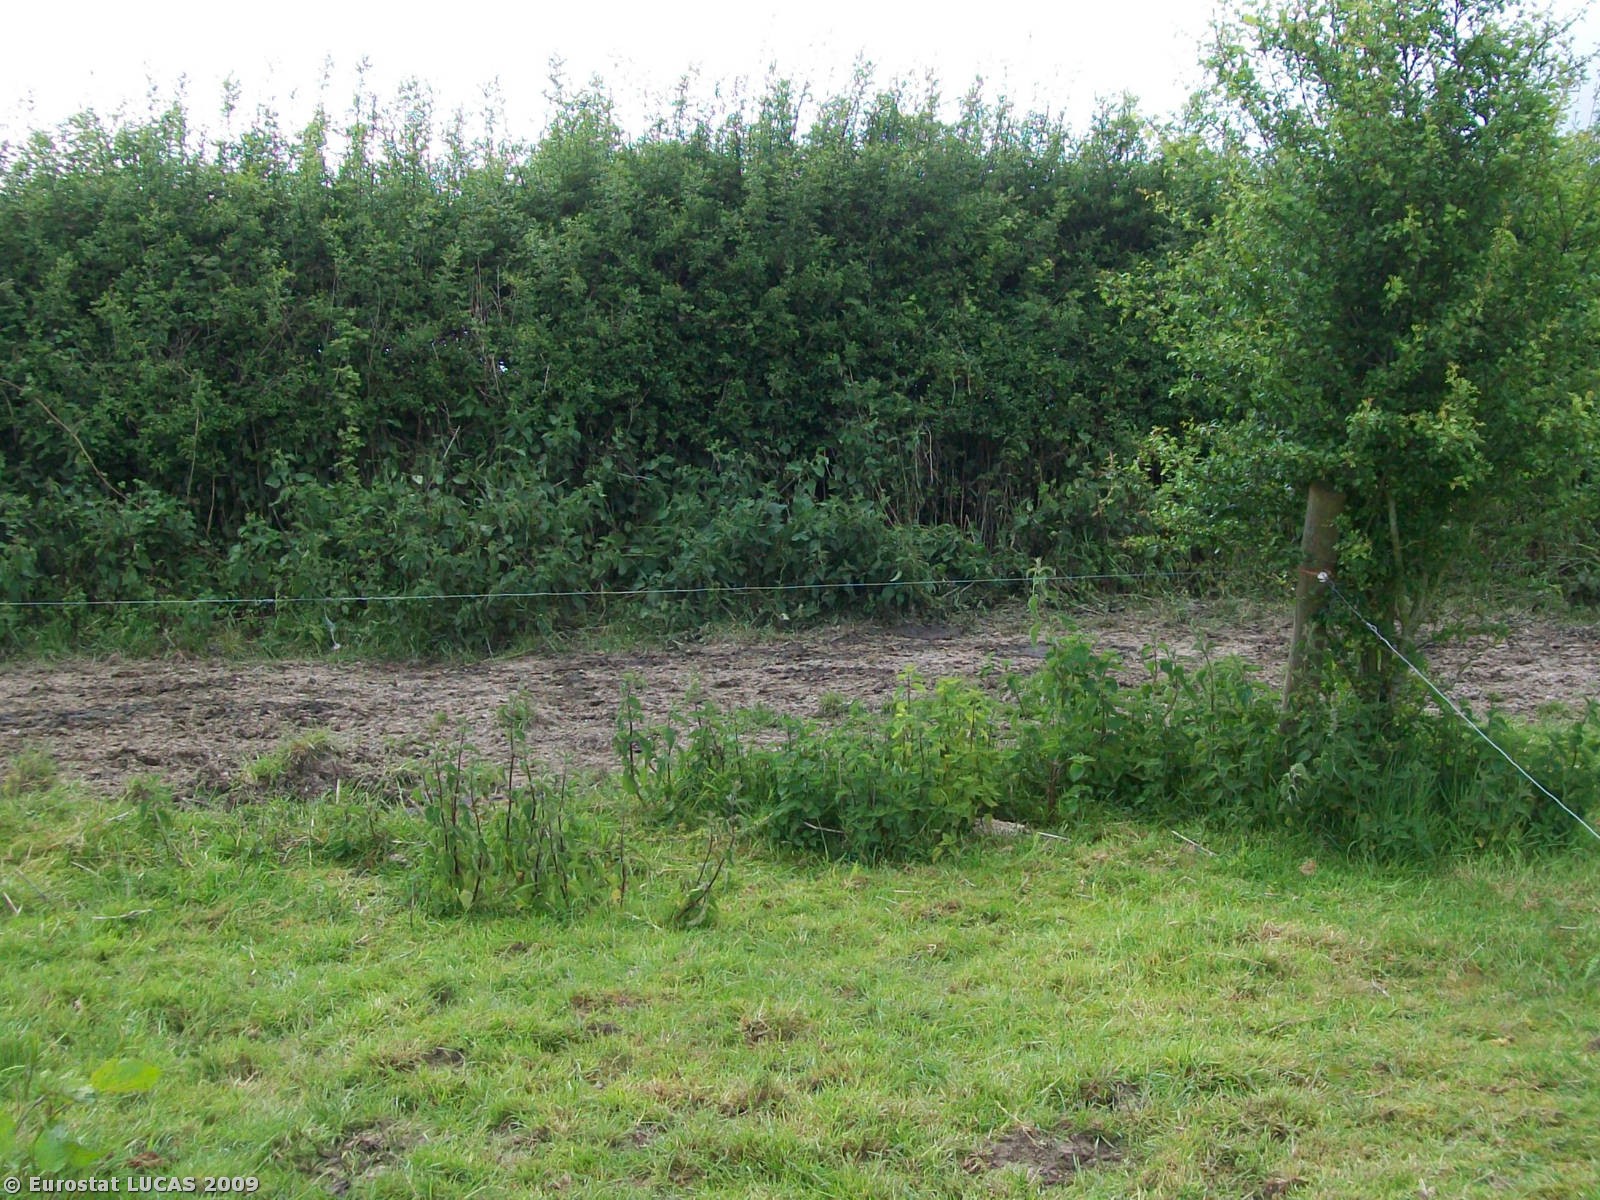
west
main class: Grassland
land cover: Grassland without tree/shrub cover
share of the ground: > 75 %
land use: Agriculture (excluding fallow land and kitchen gardens)
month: May
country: GB
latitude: 51.0569
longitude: -2.1739
